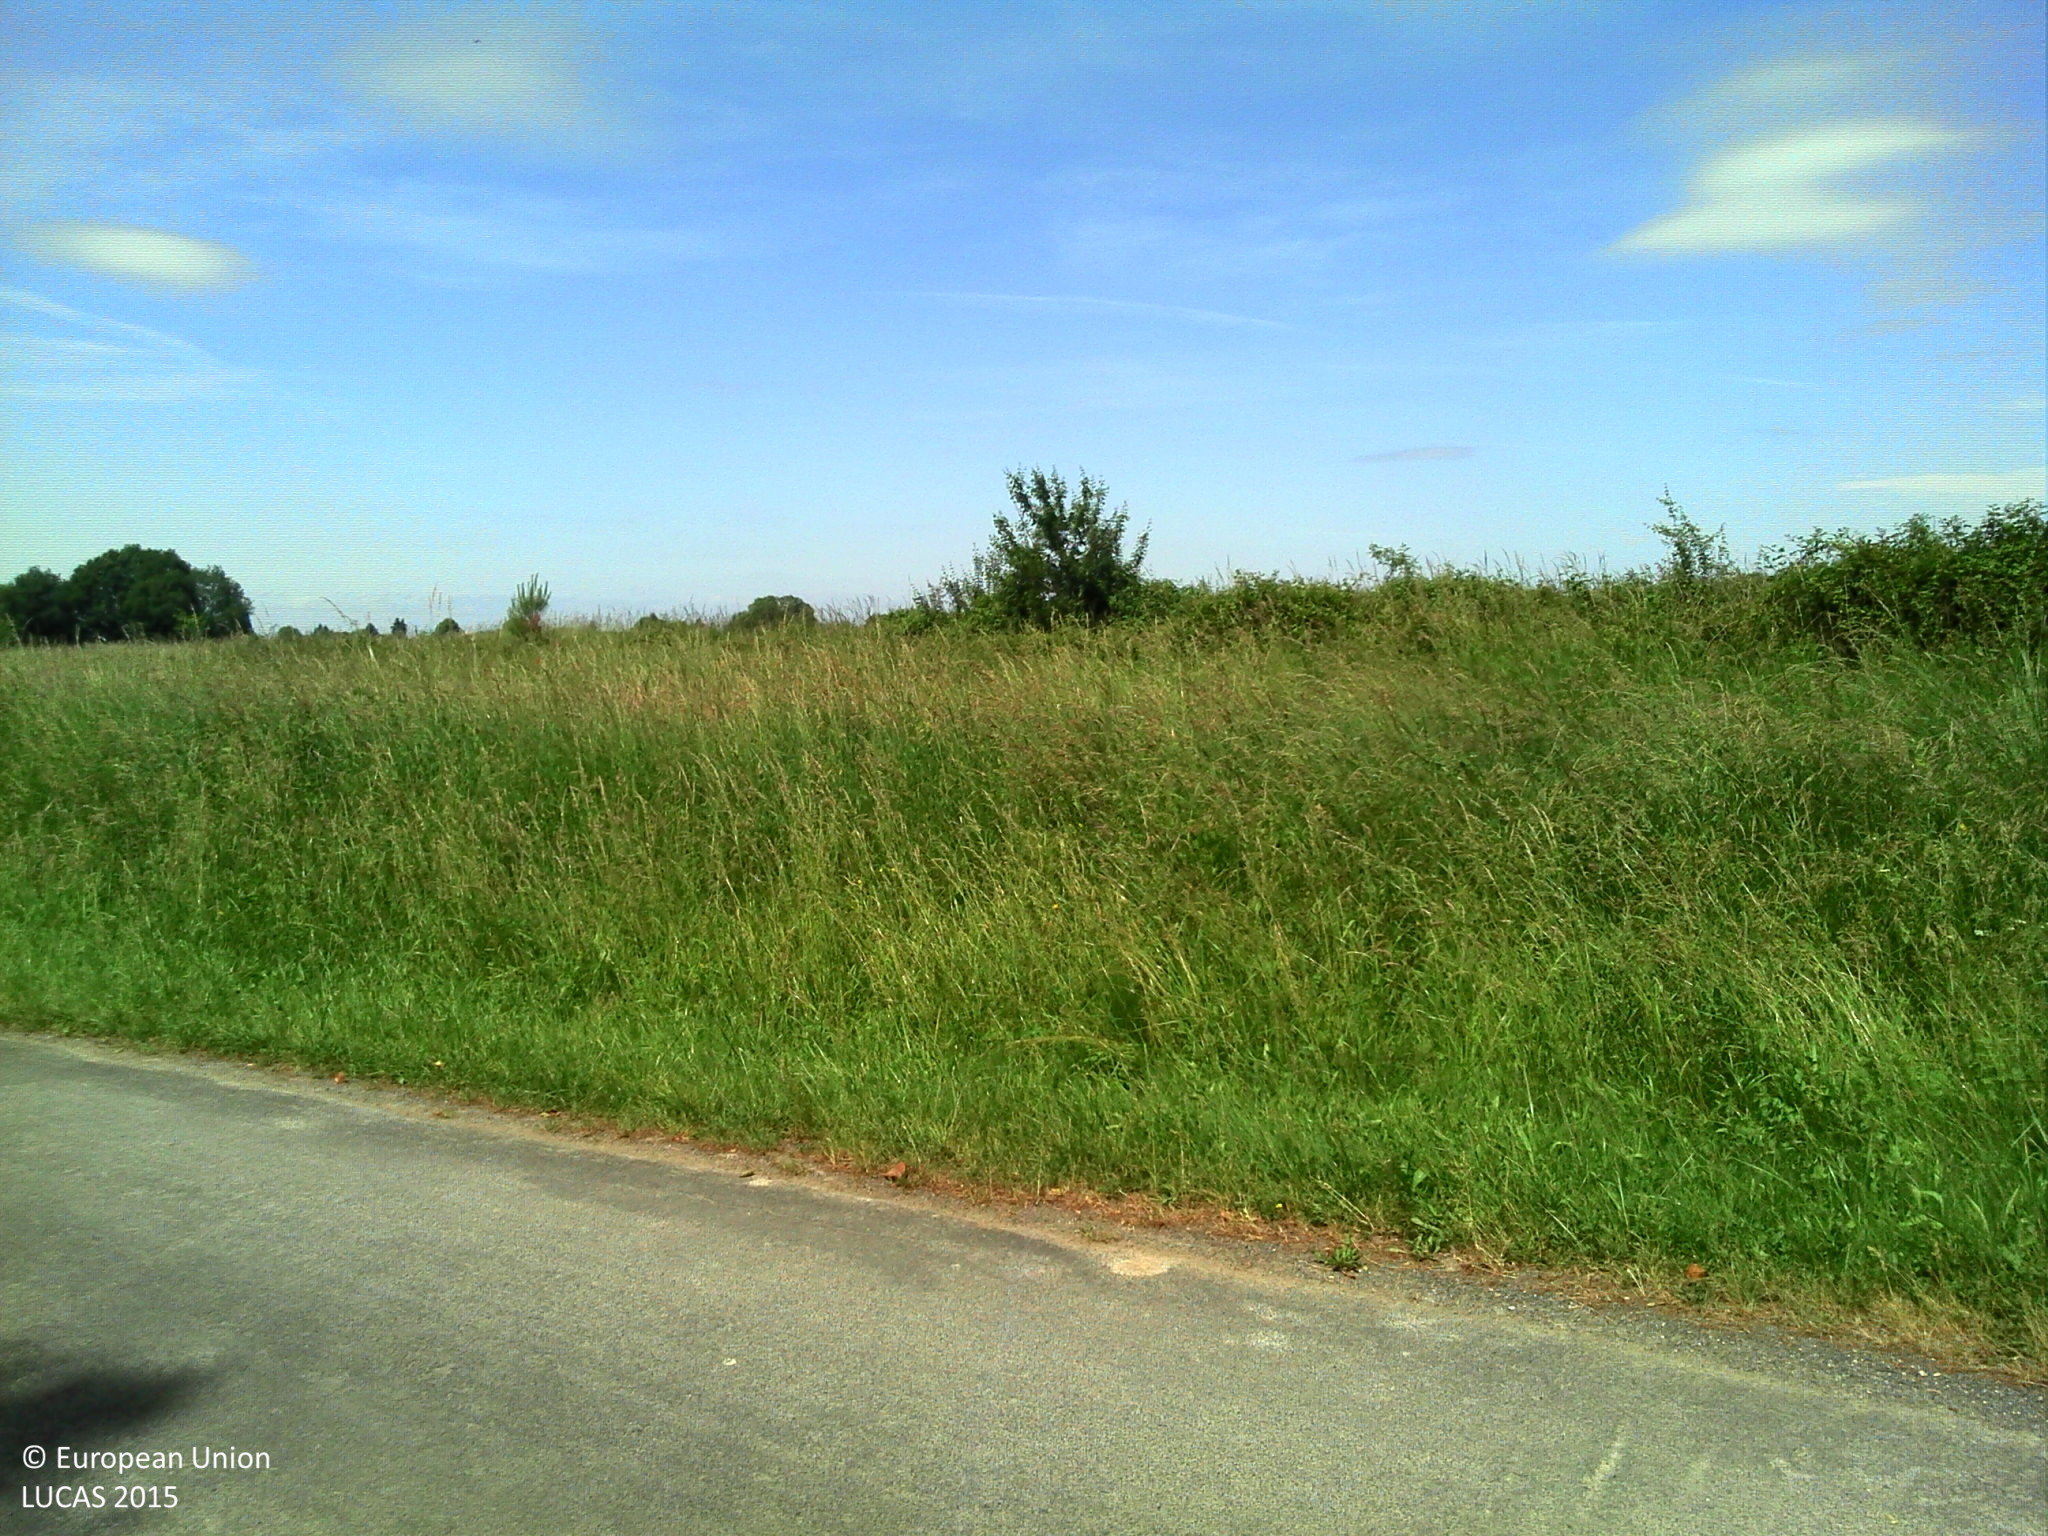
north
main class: Woodland
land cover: Broadleaved woodland
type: mesophytic deciduous forest
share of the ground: > 75 %
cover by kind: broadleaved forest trees 85 %, shrubs 10 %, herbaceous plants 5 %
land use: Forestry
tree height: > 5 m
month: June
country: FR
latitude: 46.9997
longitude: 0.1271
